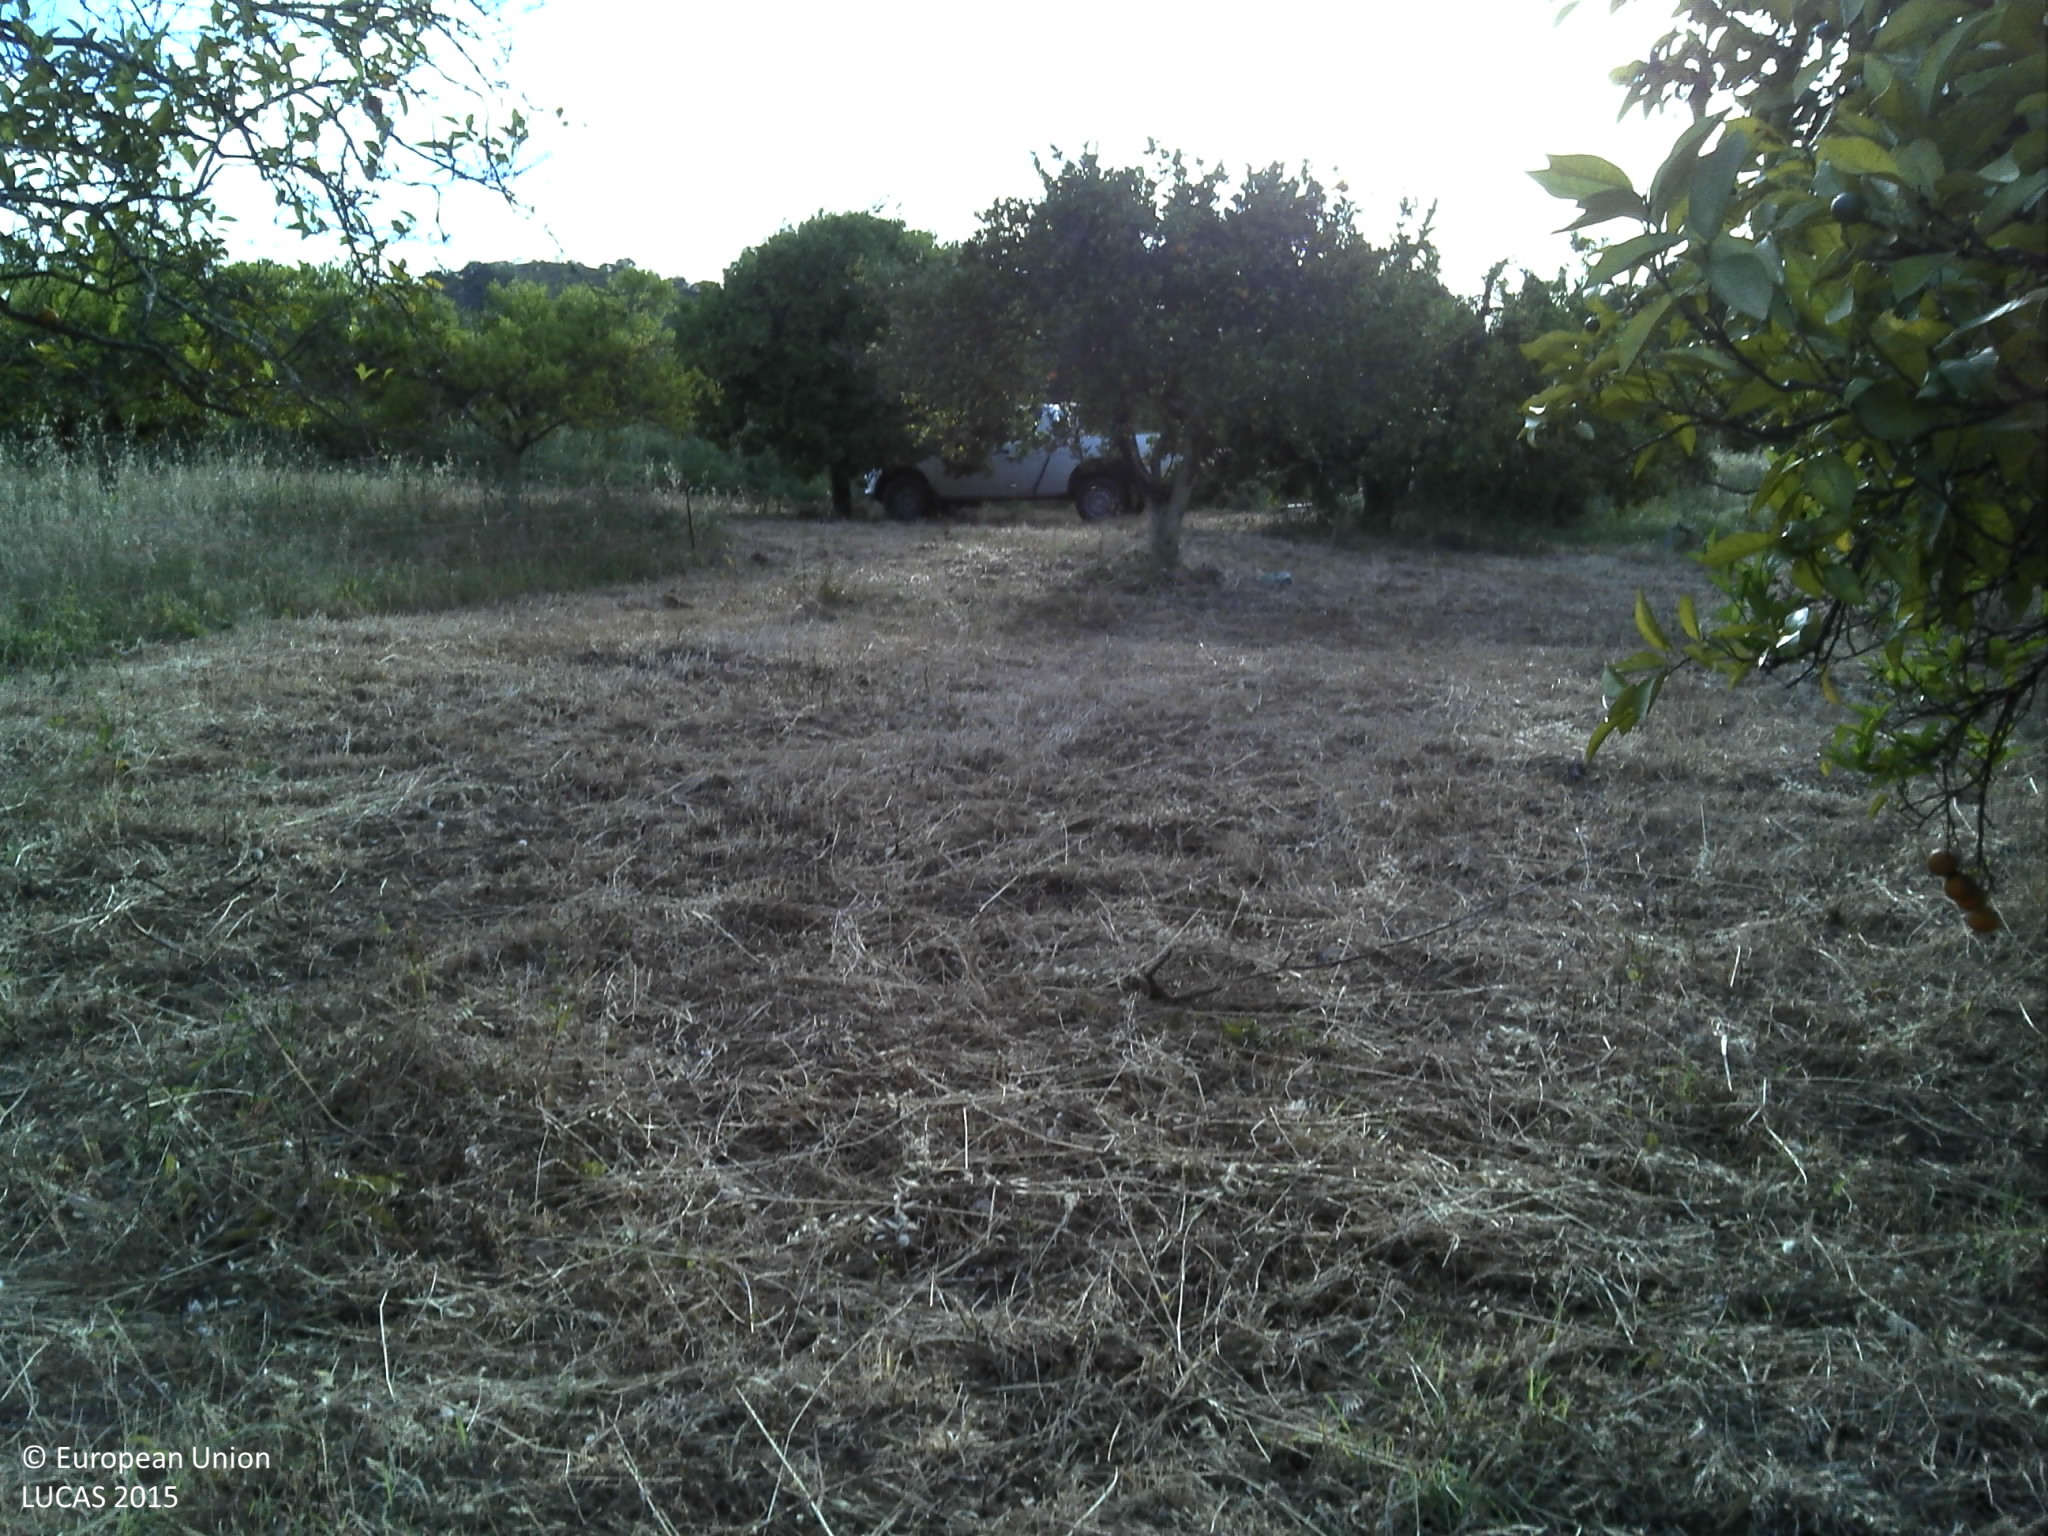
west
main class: Cropland
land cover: Other citrus fruit
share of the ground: 50 - 75 %
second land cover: Grassland without tree/shrub cover
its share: 50 - 75 %
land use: Agriculture (excluding fallow land and kitchen gardens)
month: May
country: PT
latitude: 37.2634
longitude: -7.4703
